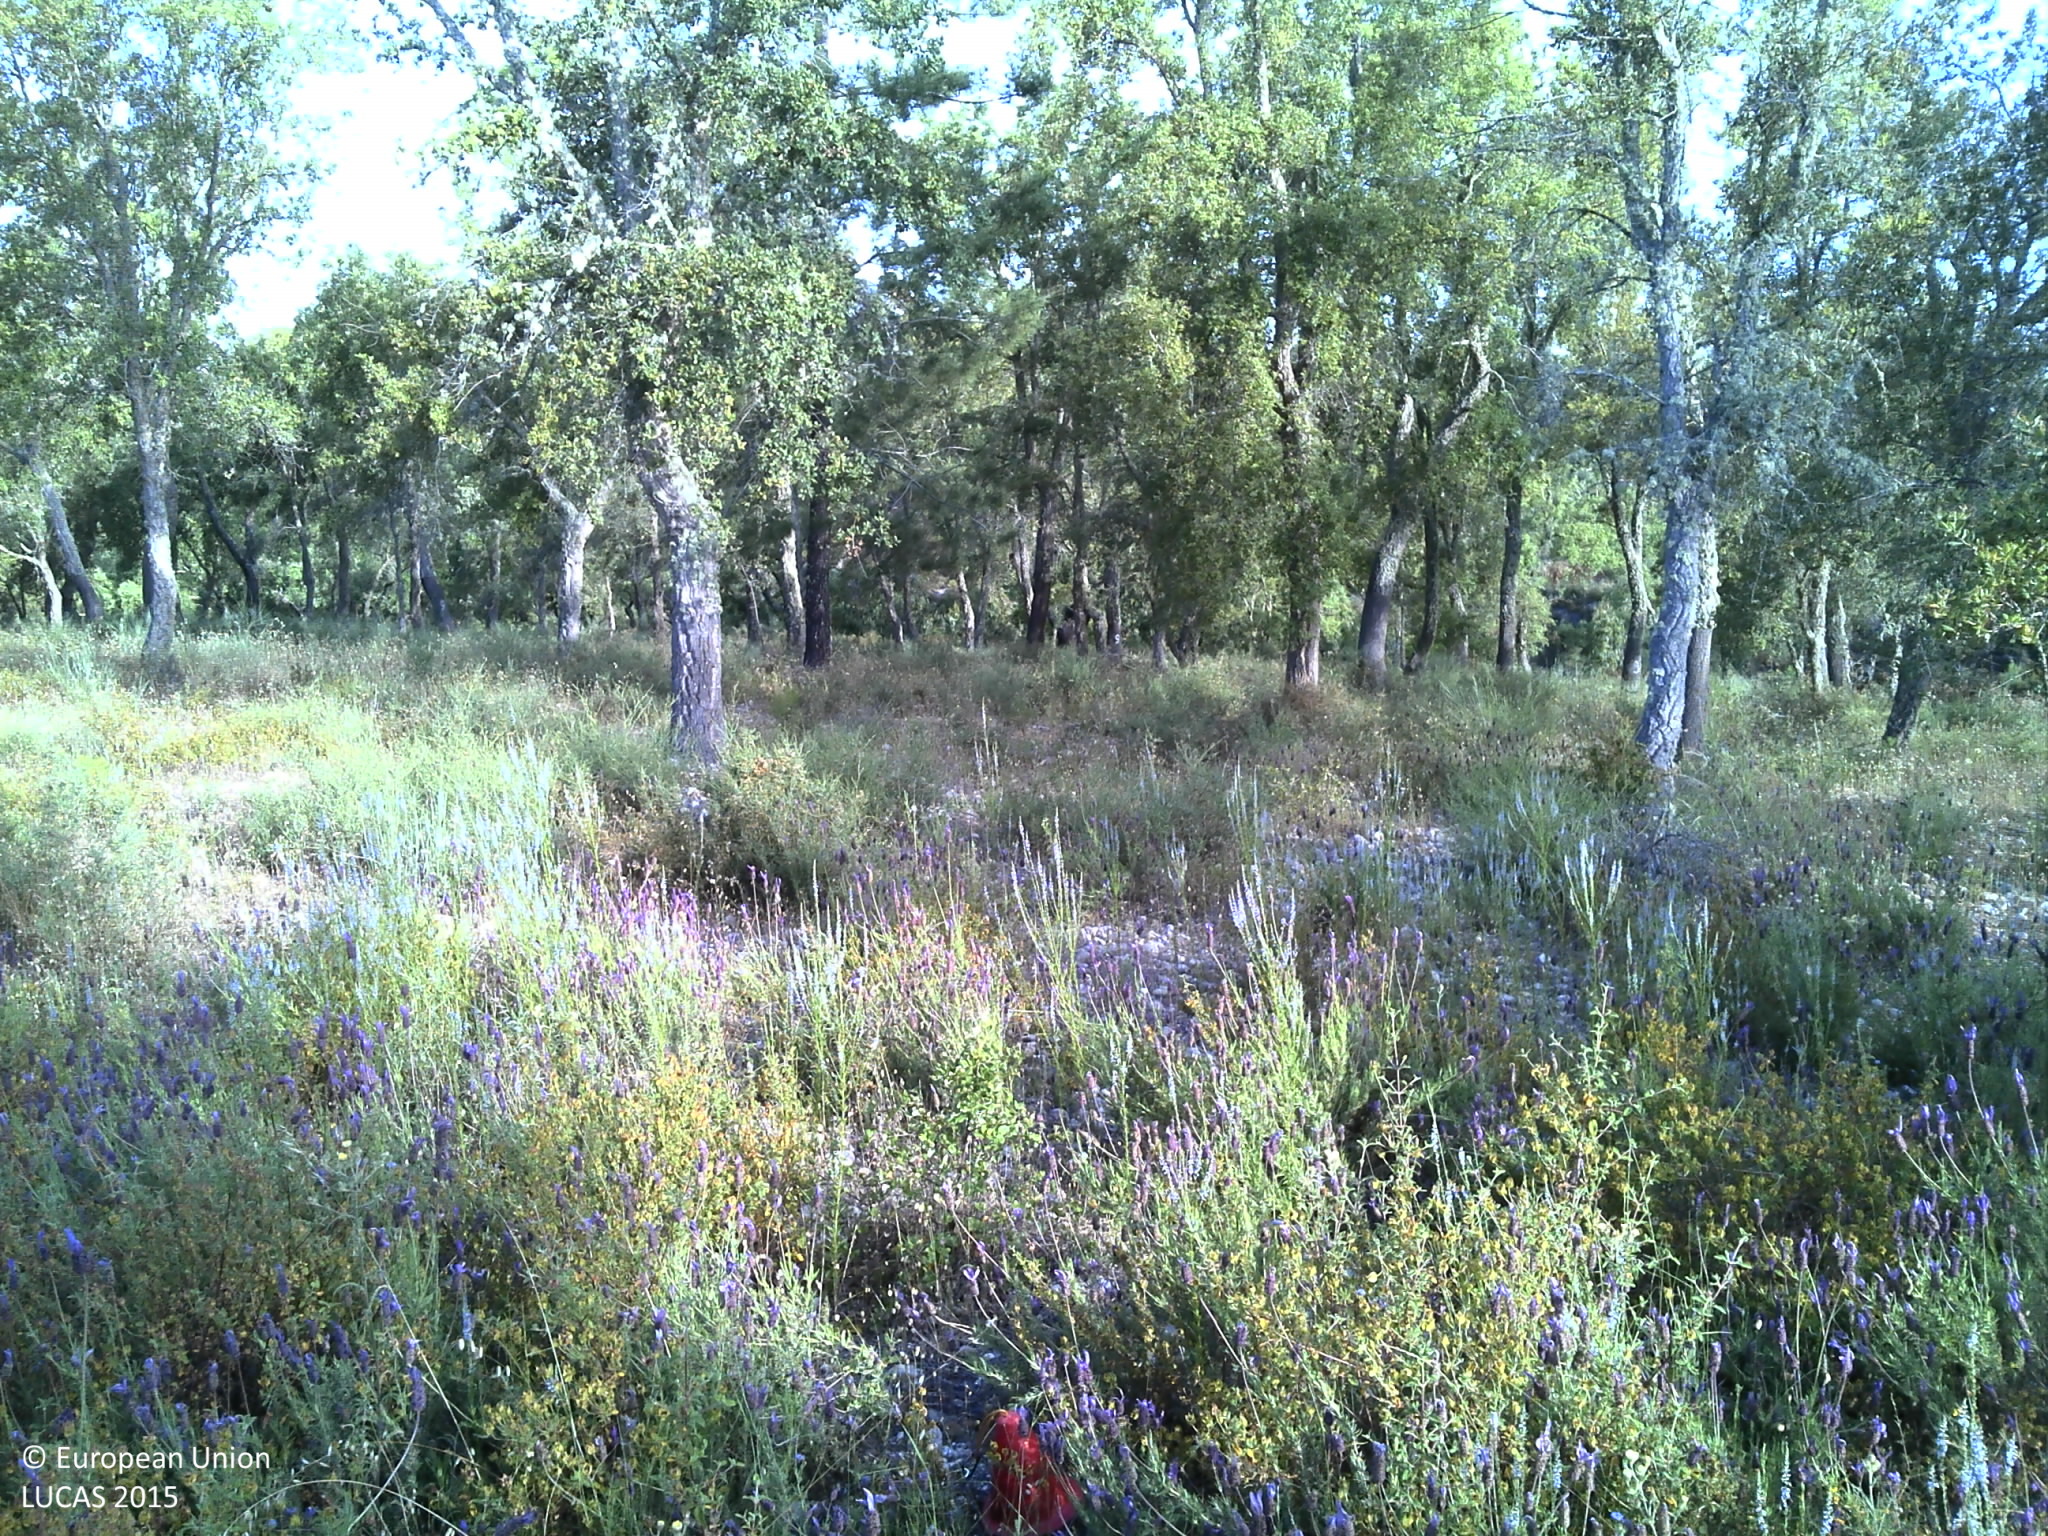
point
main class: Woodland
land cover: Broadleaved woodland
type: broadleaved evergreen forest
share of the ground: 25 - 50 %
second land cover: Shrubland without tree cover
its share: 50 - 75 %
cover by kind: broadleaved forest trees 30 %, shrubs 30 %, herbaceous plants 20 %, unconsolidated bare surface 20 %
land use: Forestry
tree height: > 5 m
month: May
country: PT
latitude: 39.3303
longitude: -7.9788
